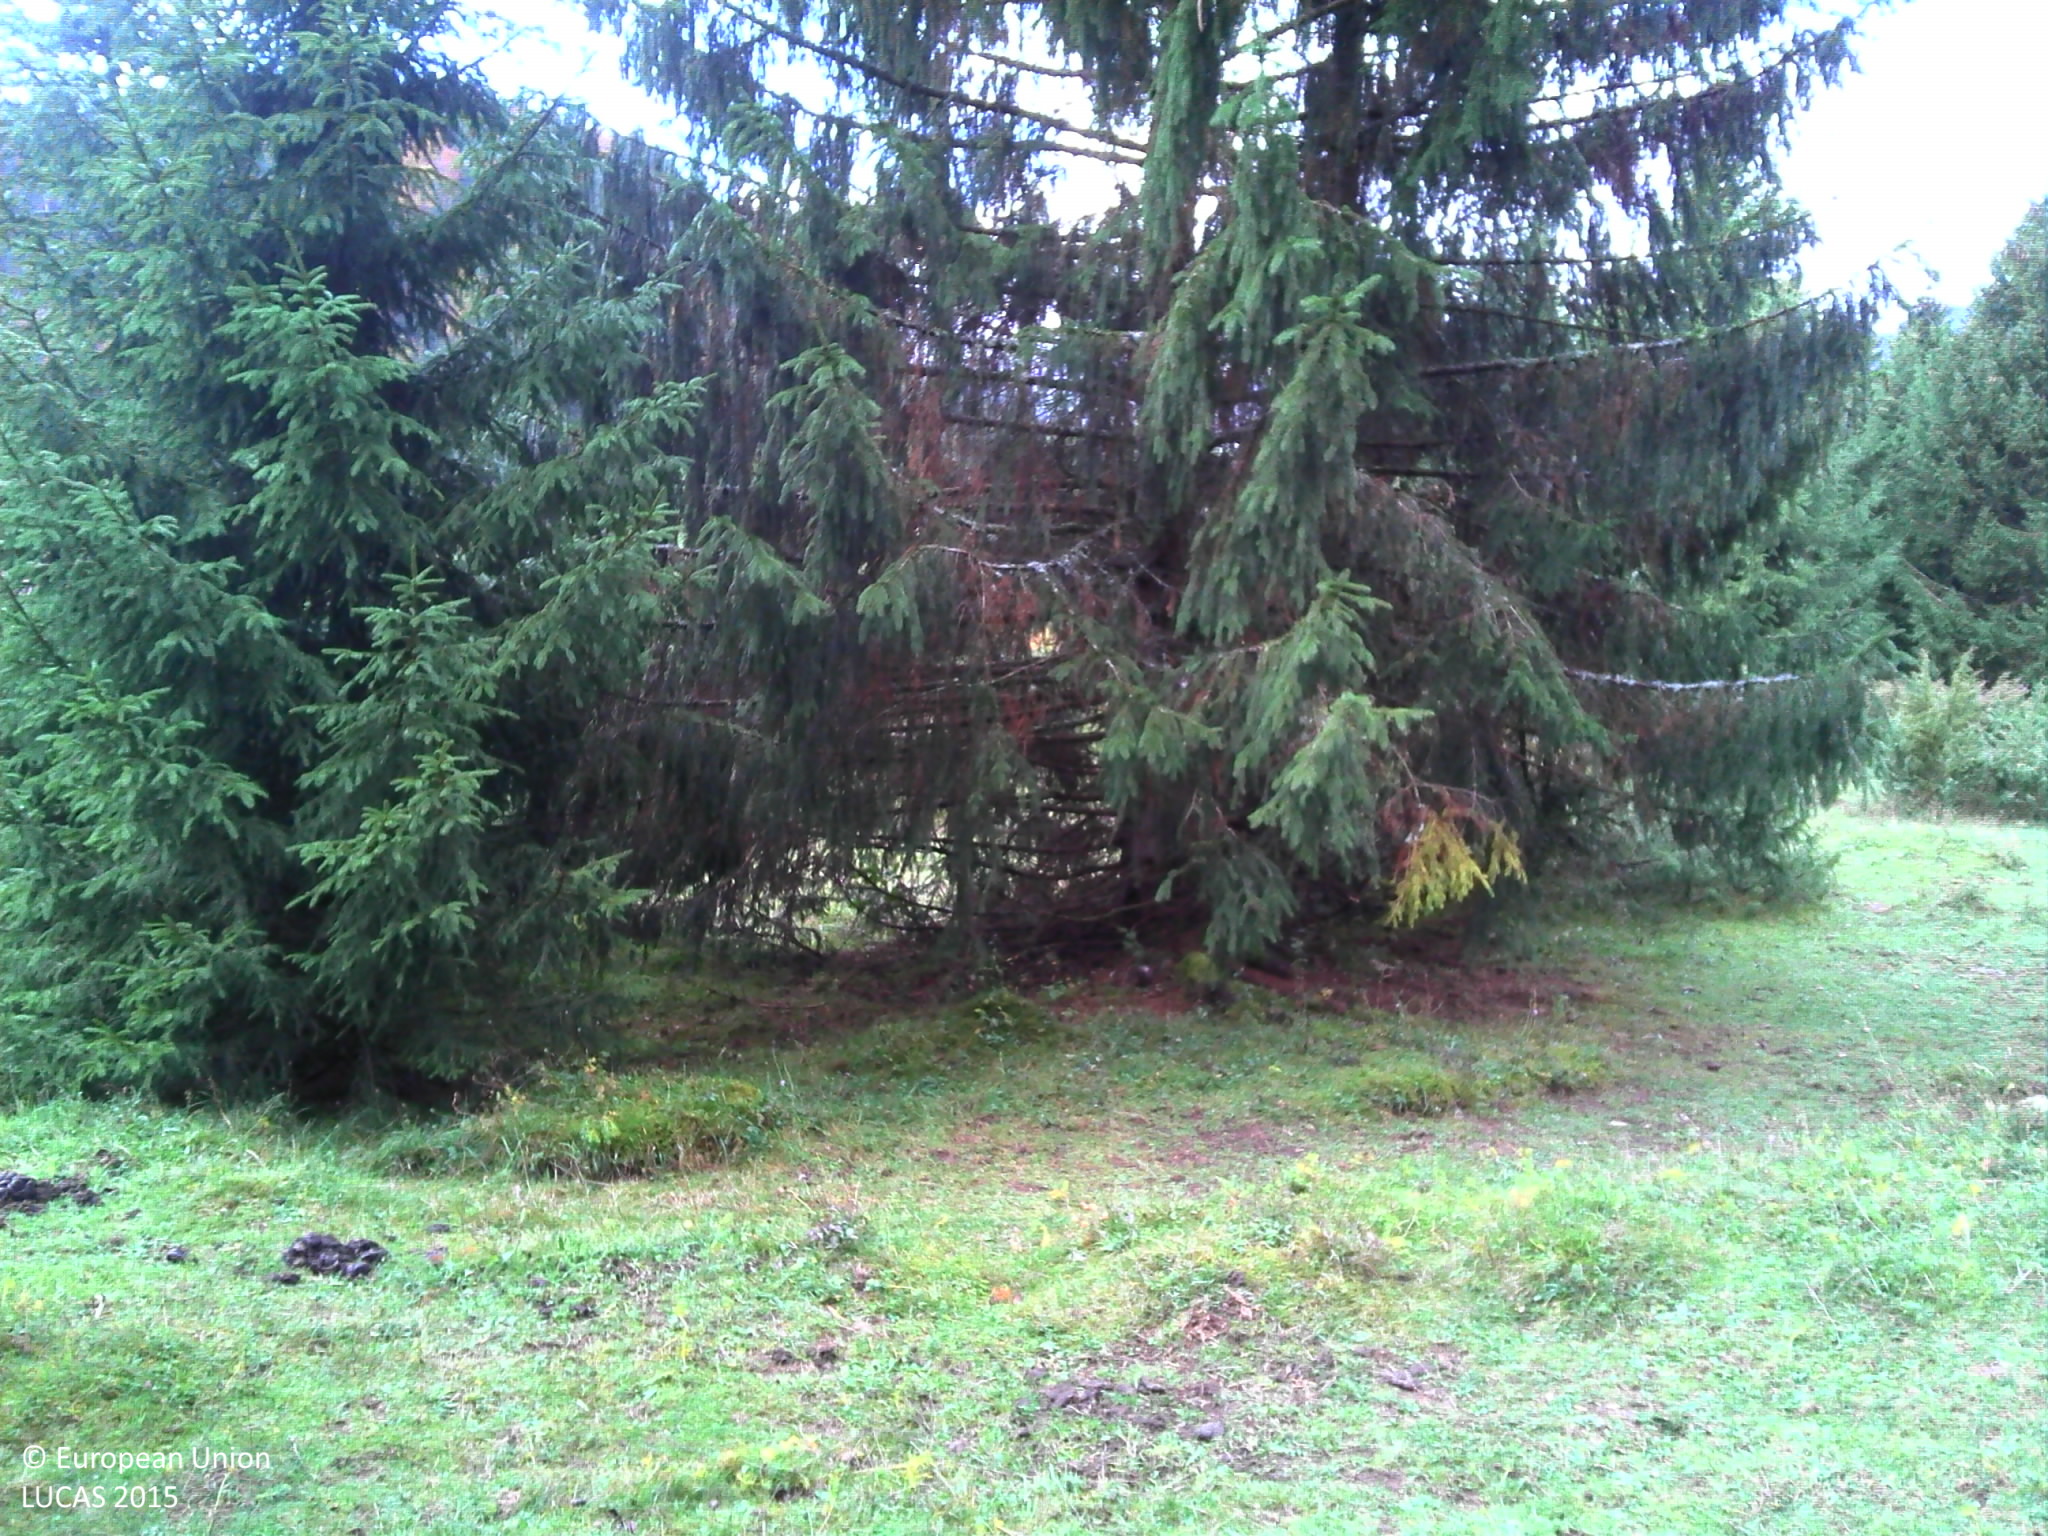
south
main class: Woodland
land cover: Spruce dominated coniferous woodland
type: alpine coniferous forest
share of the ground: > 75 %
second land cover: Grassland without tree/shrub cover
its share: 10 - 25 %
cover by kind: coniferous forest trees 75 %, herbaceous plants 25 %
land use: Forestry
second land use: Agriculture (excluding fallow land and kitchen gardens)
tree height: > 5 m
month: October
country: FR
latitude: 46.8665
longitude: 6.3686
